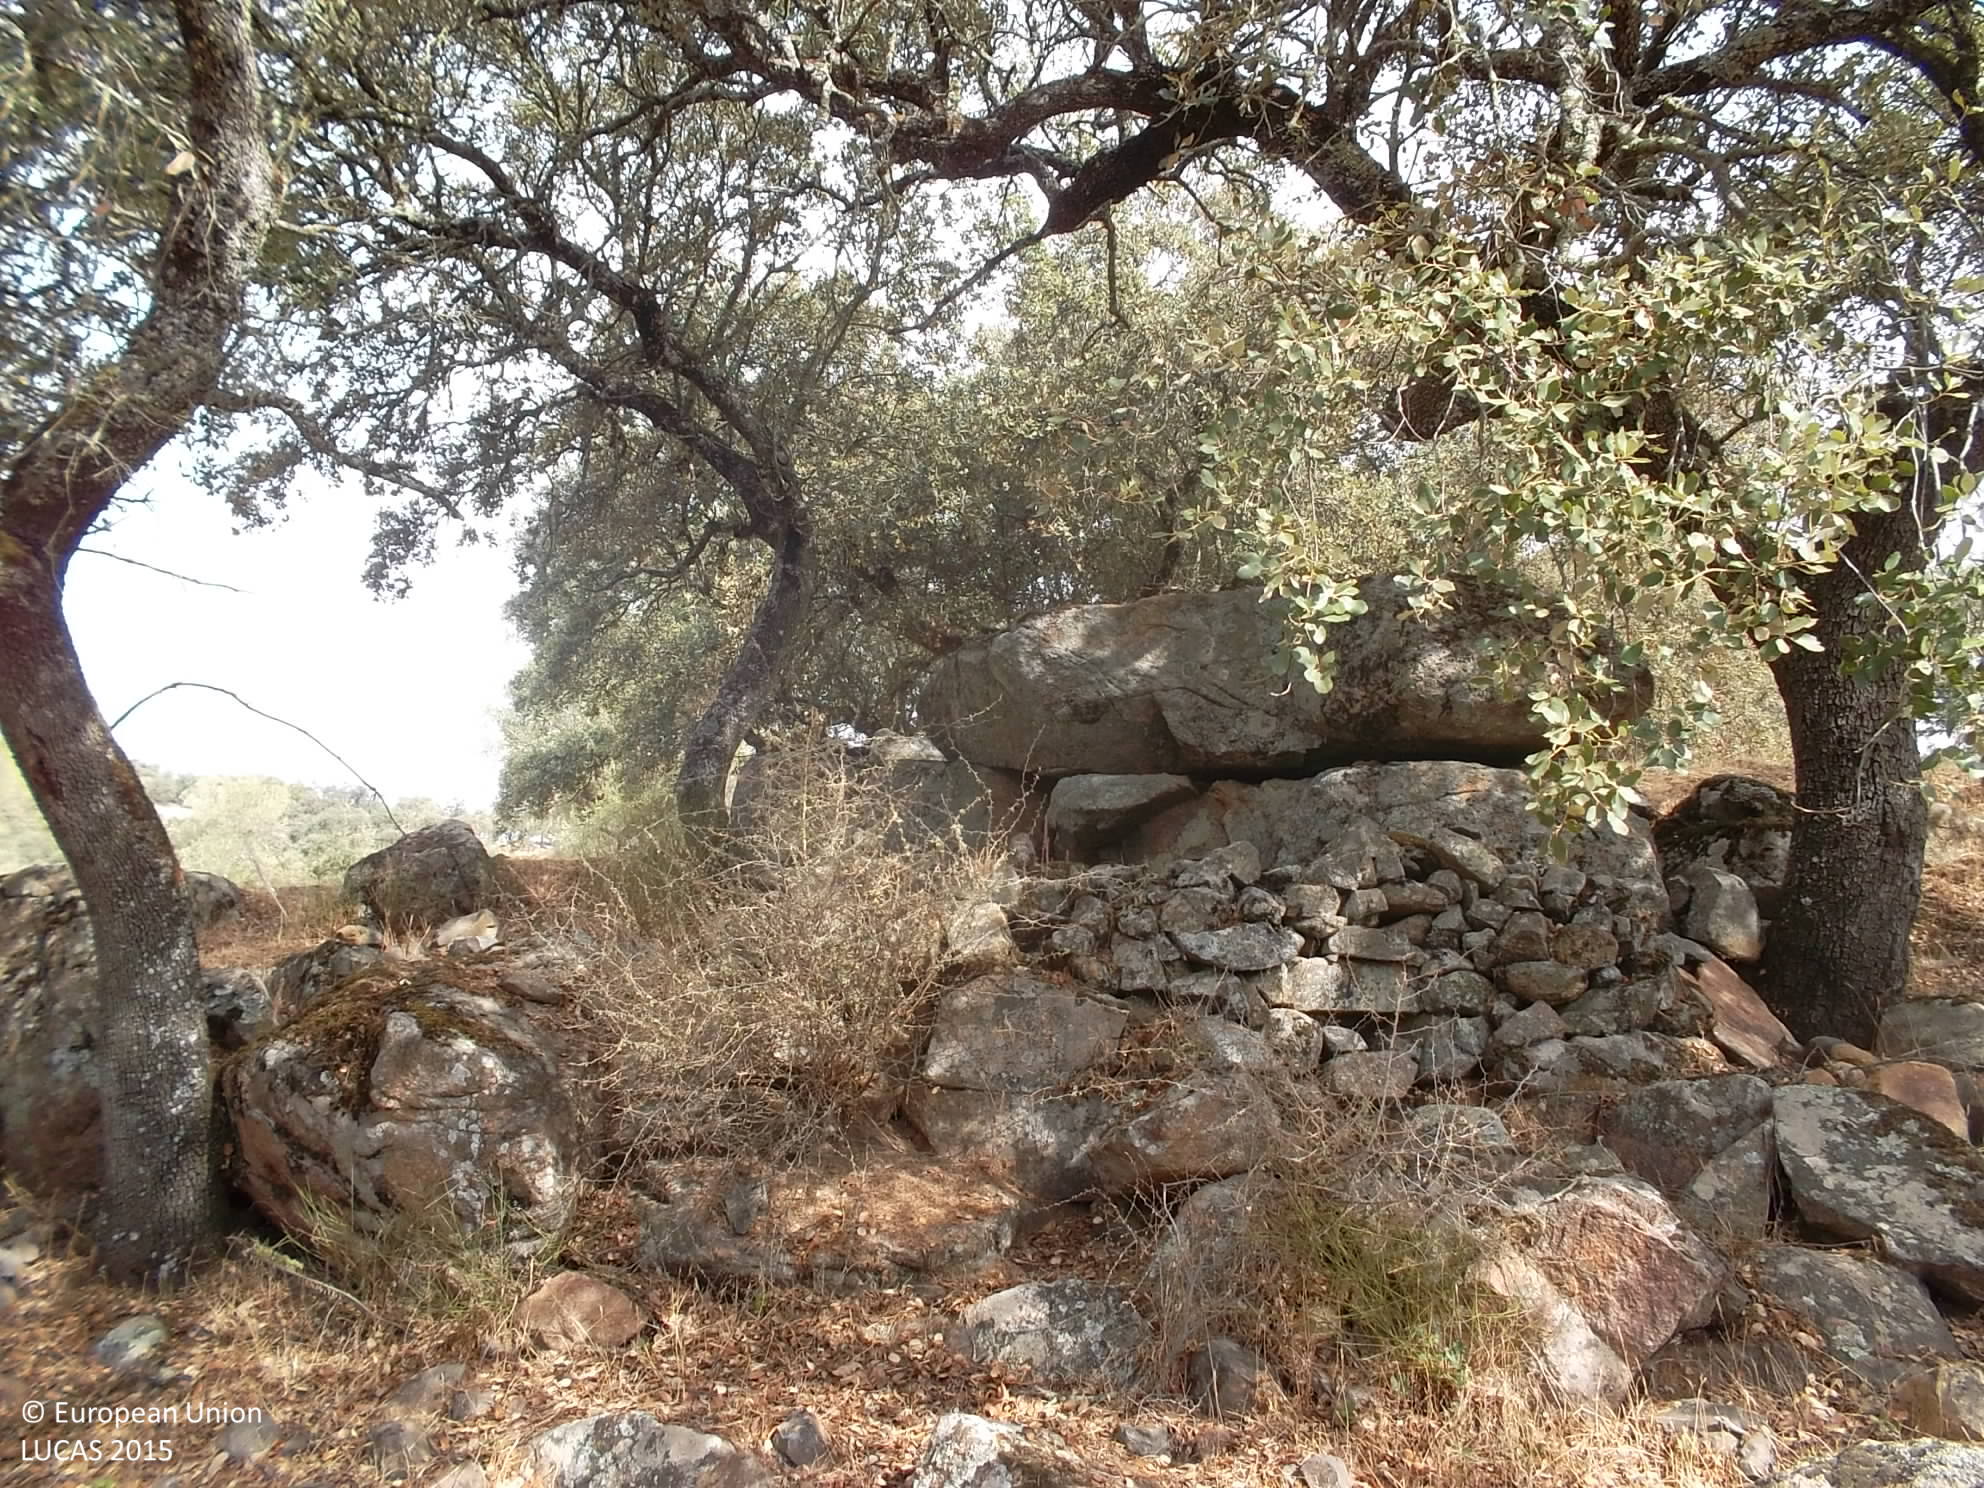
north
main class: Woodland
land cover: Broadleaved woodland
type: broadleaved evergreen forest
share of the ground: 25 - 50 %
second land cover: Grassland without tree/shrub cover
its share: 25 - 50 %
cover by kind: broadleaved forest trees 40 %, herbaceous plants 40 %, consolidated bare surface 20 %
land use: Forestry
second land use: Agriculture (excluding fallow land and kitchen gardens)
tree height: > 5 m
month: September
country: ES
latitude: 38.5053
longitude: -6.8367
